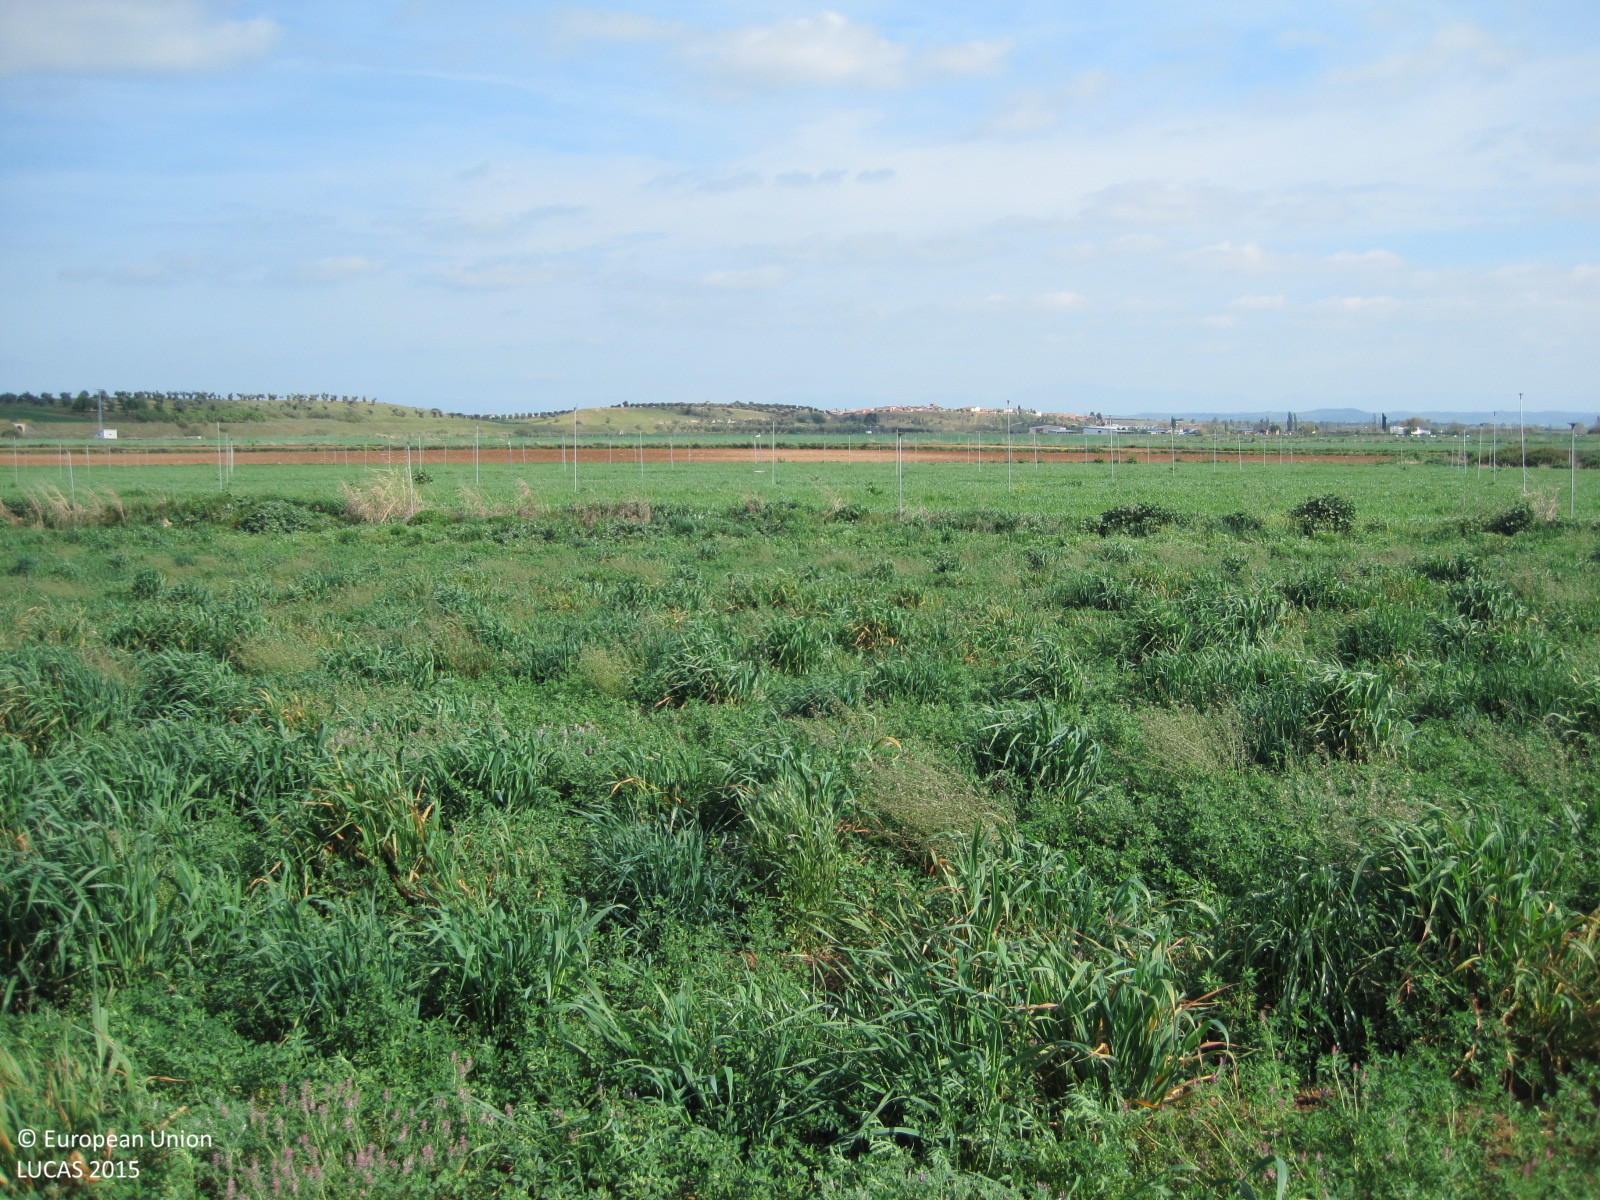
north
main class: Cropland
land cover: Mixed cereals for fodder
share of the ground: > 75 %
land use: Agriculture (excluding fallow land and kitchen gardens)
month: April
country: ES
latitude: 39.8634
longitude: -4.9769
